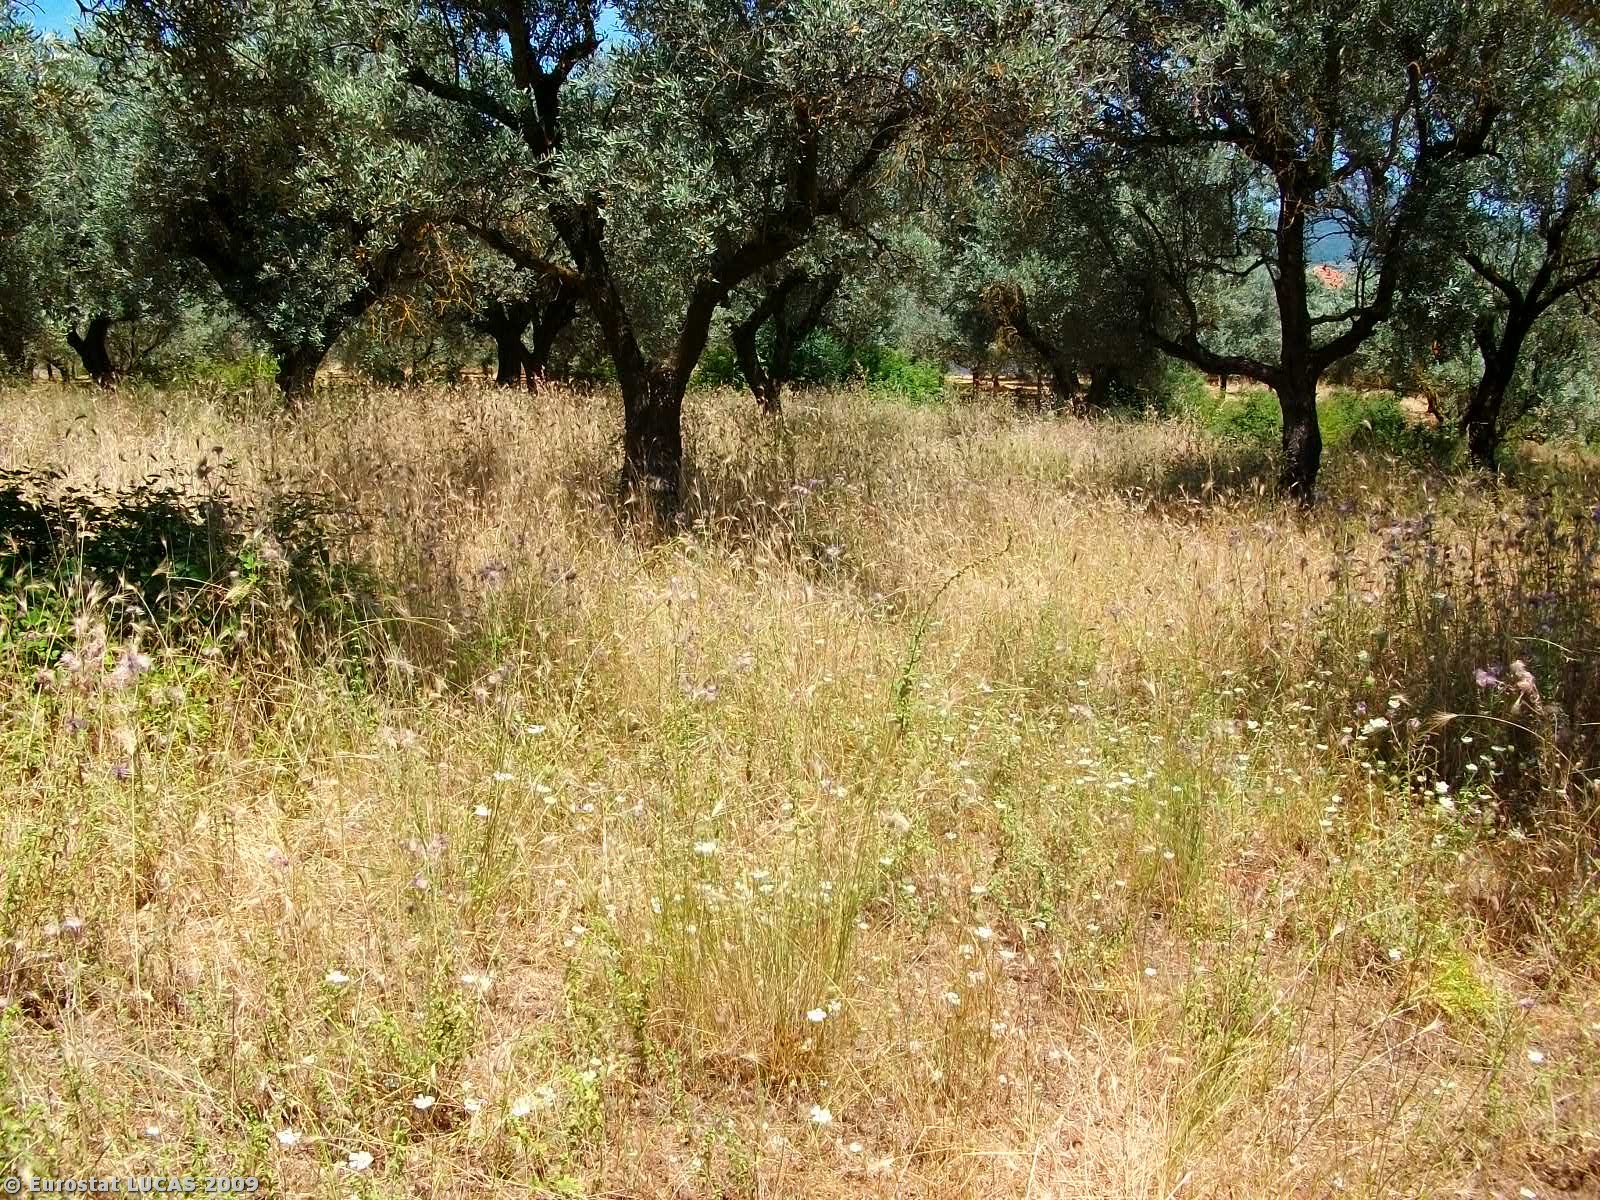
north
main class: Cropland
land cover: Olive groves
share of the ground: 50 - 75 %
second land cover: Grassland with sparse tree/shrub cover
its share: > 75 %
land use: Agriculture (excluding fallow land and kitchen gardens)
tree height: < 5 m
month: June
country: GR
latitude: 38.6064
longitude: 21.4649
